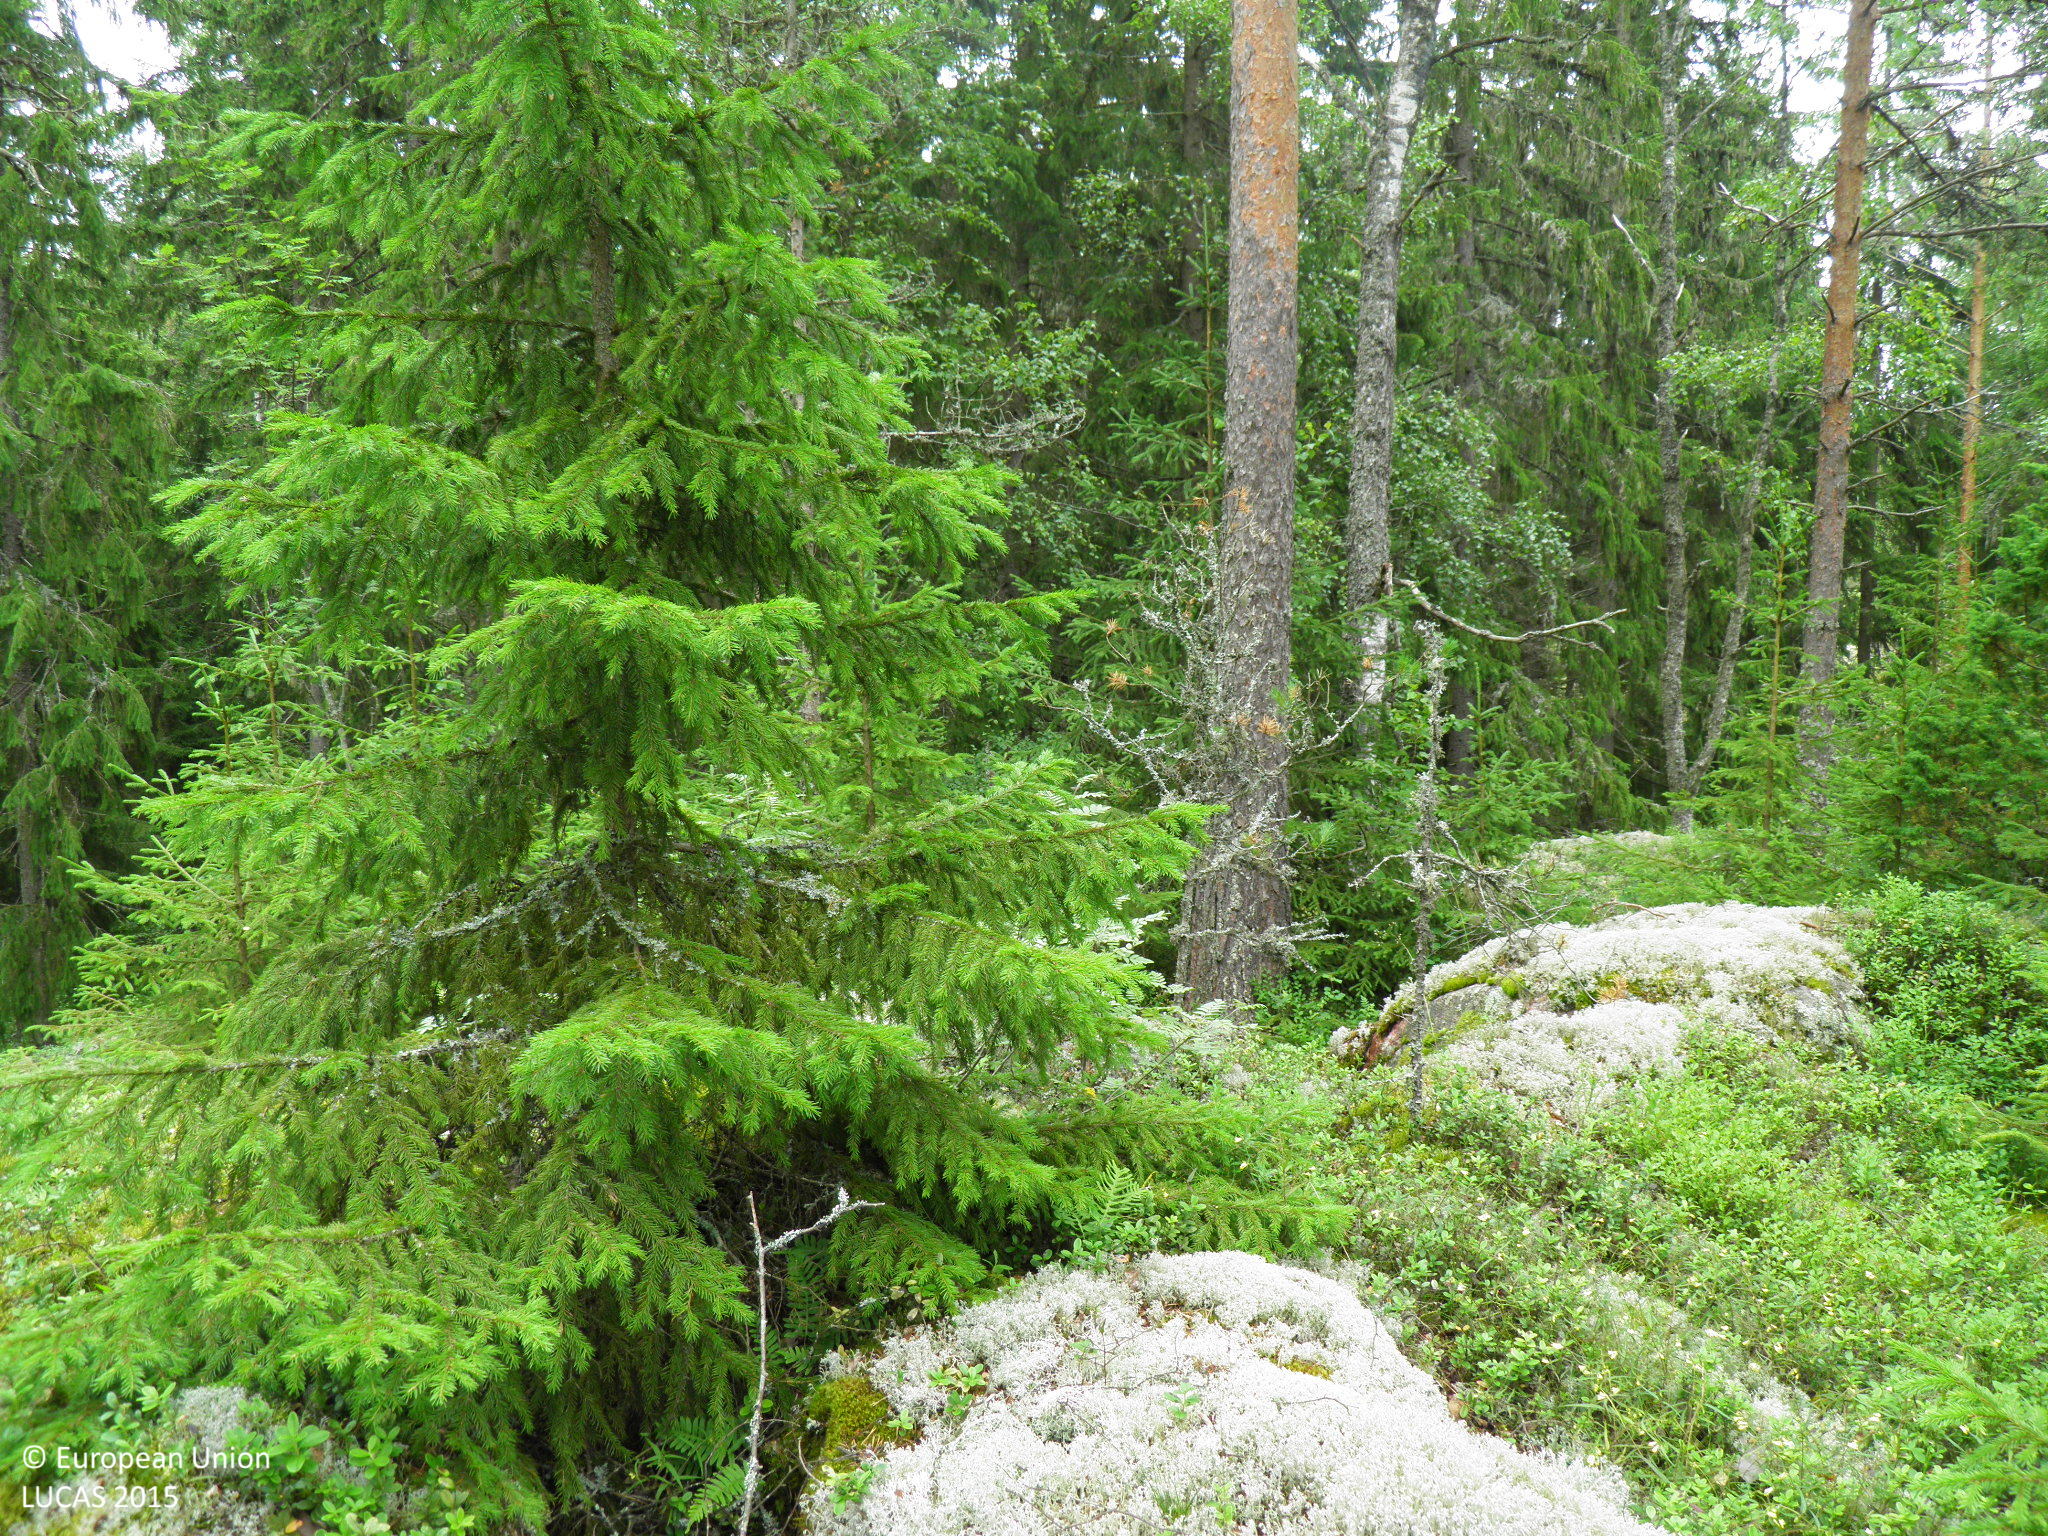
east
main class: Woodland
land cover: Other coniferous woodland
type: hemiboreal forest and nemoral coniferous forest and mixed broadleaved-coniferous forest
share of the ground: 25 - 50 %
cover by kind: lichens and mosses 50 %, coniferous forest trees 30 %, broadleaved forest trees 10 %, shrubs 10 %
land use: Forestry
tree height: > 5 m
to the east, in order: Other coniferous woodland
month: July
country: FI
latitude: 60.6099
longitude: 21.6208
